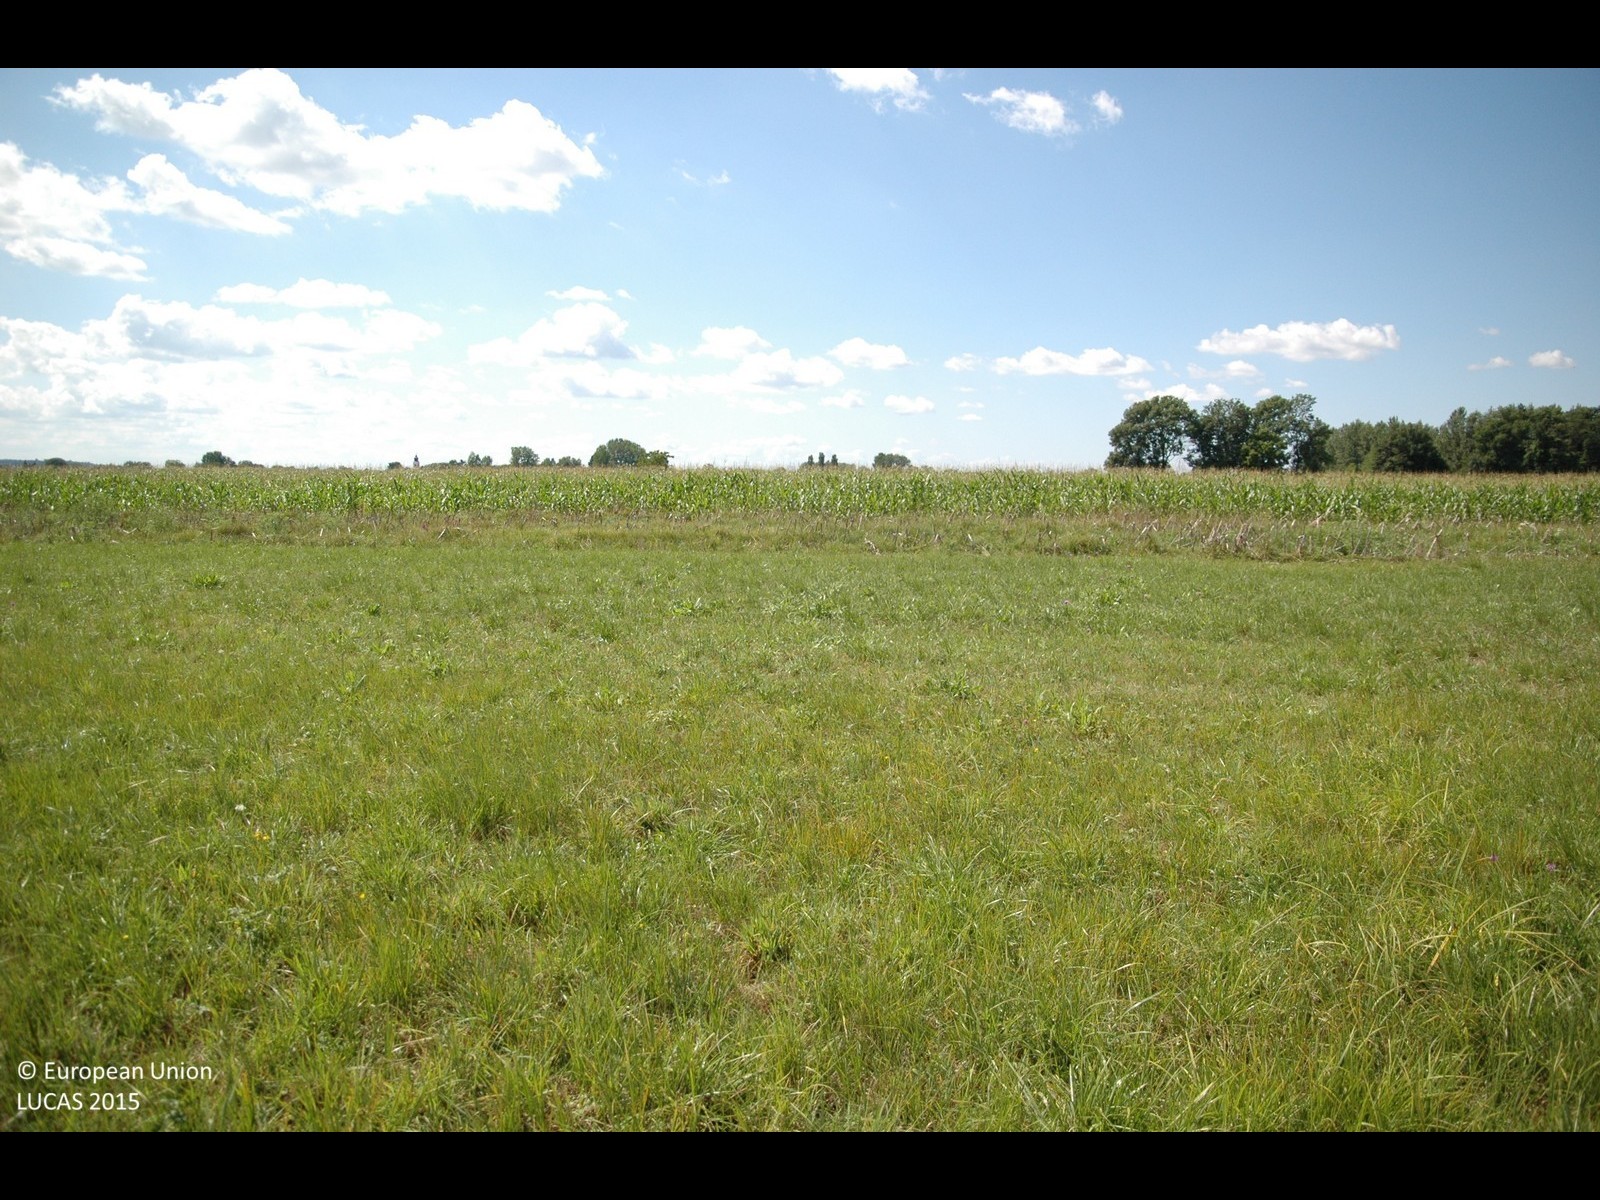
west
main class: Grassland
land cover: Grassland without tree/shrub cover
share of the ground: > 75 %
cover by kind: herbaceous plants 100 %
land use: Agriculture (excluding fallow land and kitchen gardens)
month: July
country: HR
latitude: 46.2490
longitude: 16.7069
